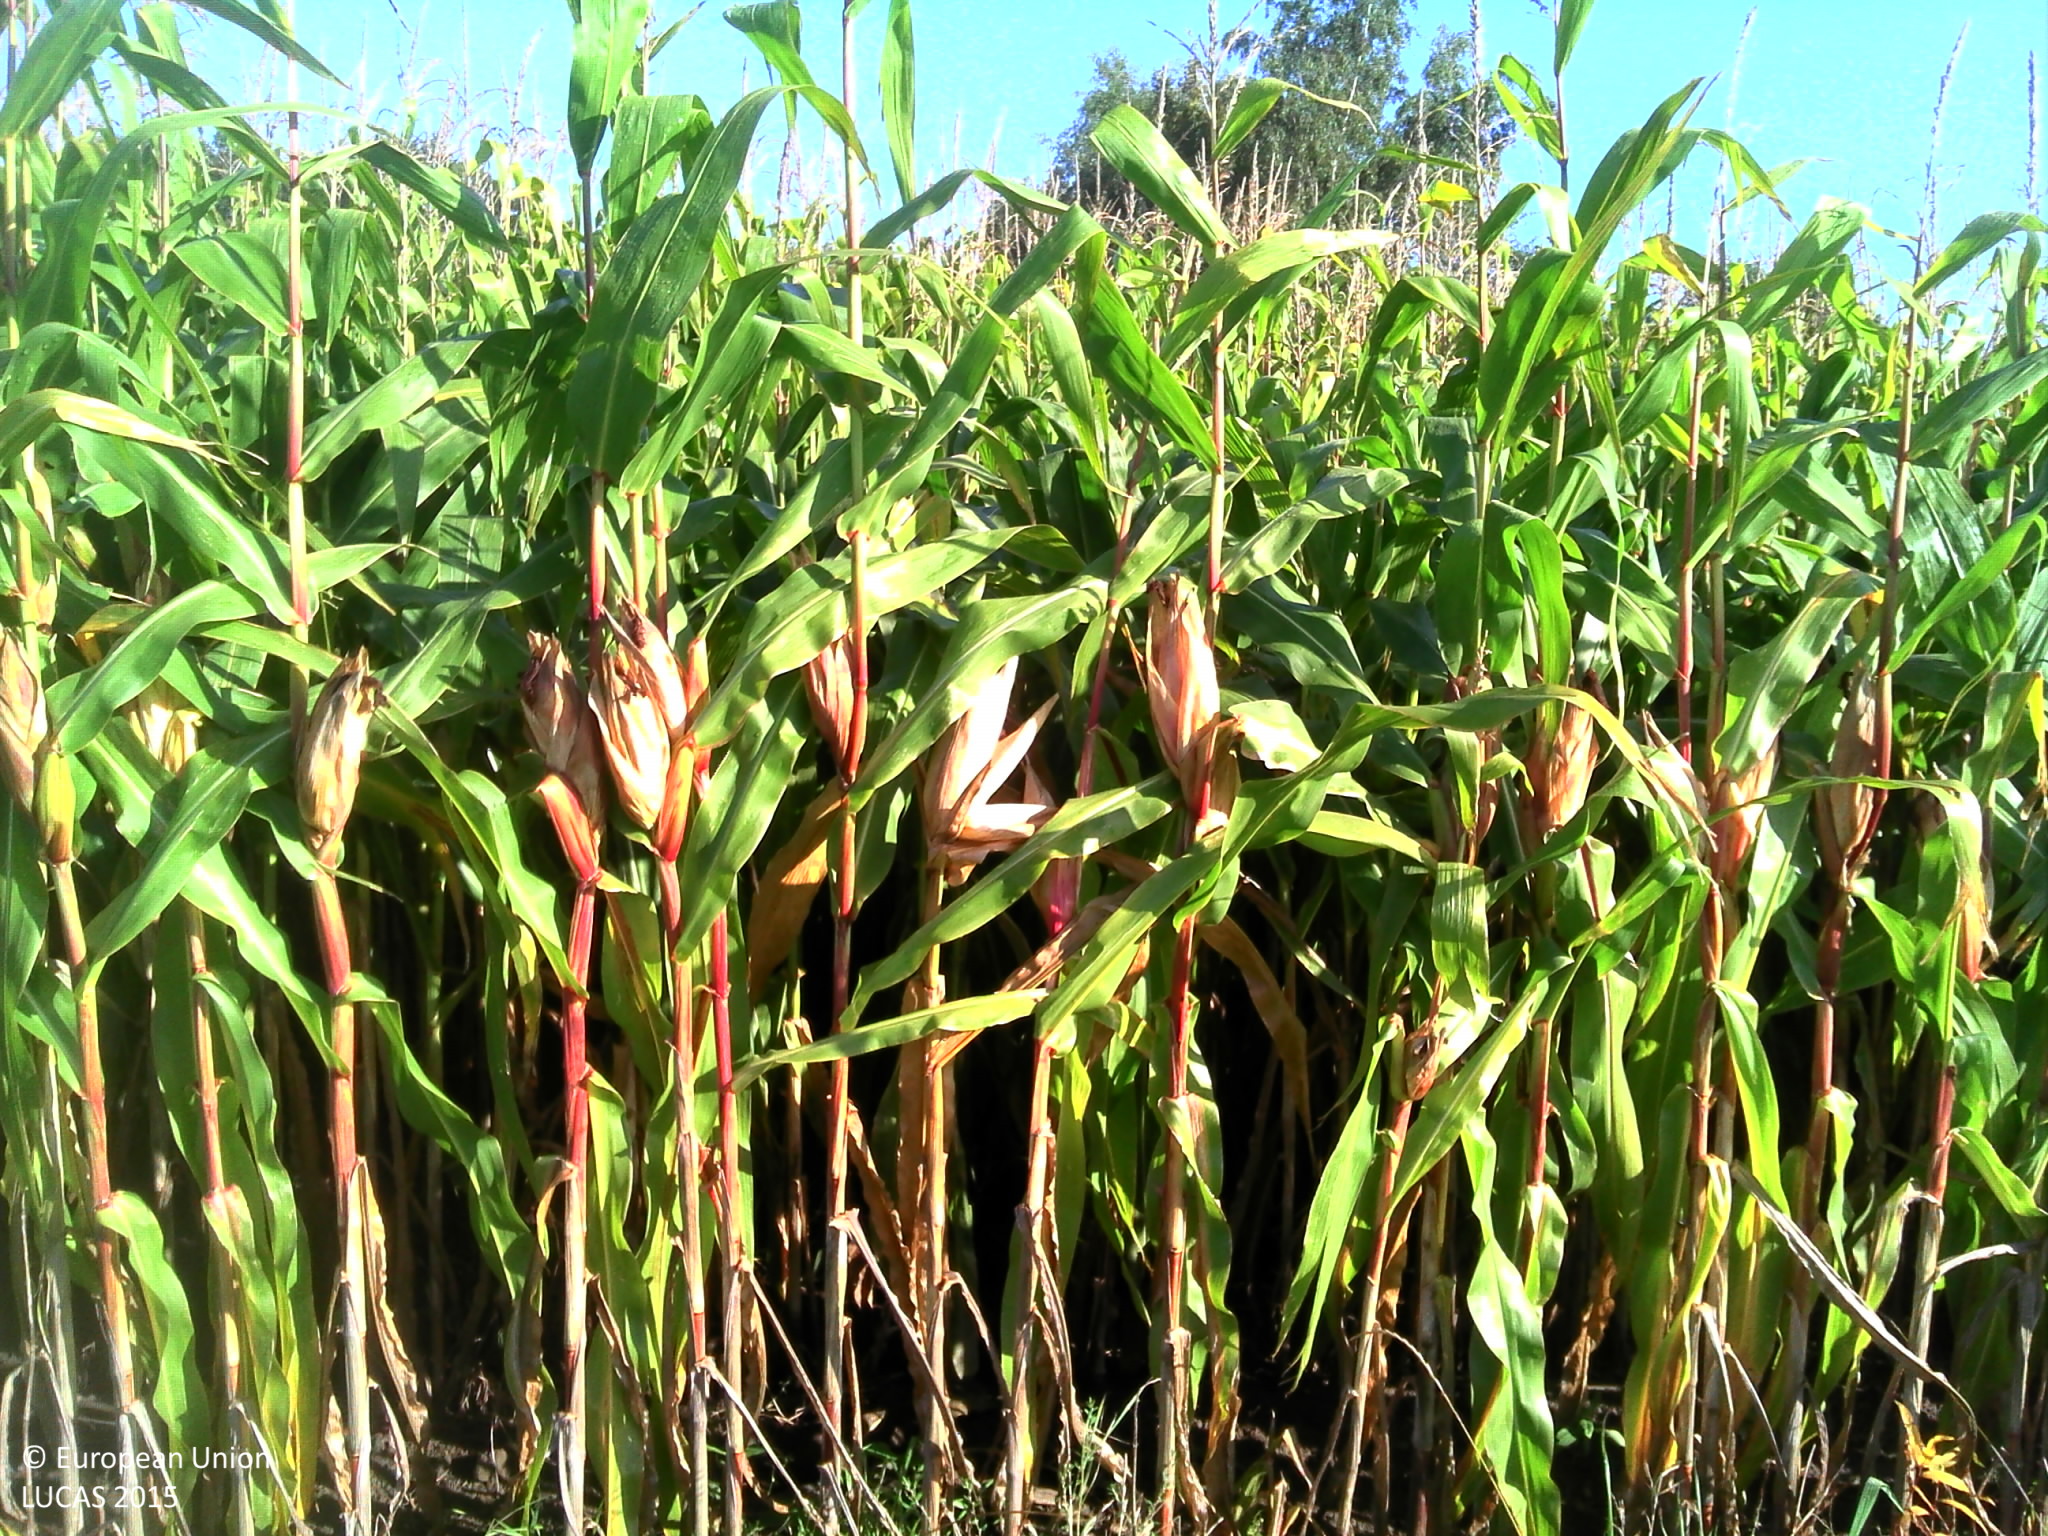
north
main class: Cropland
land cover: Maize
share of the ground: > 75 %
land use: Agriculture (excluding fallow land and kitchen gardens)
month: September
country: BE
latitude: 51.0940
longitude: 4.4412
